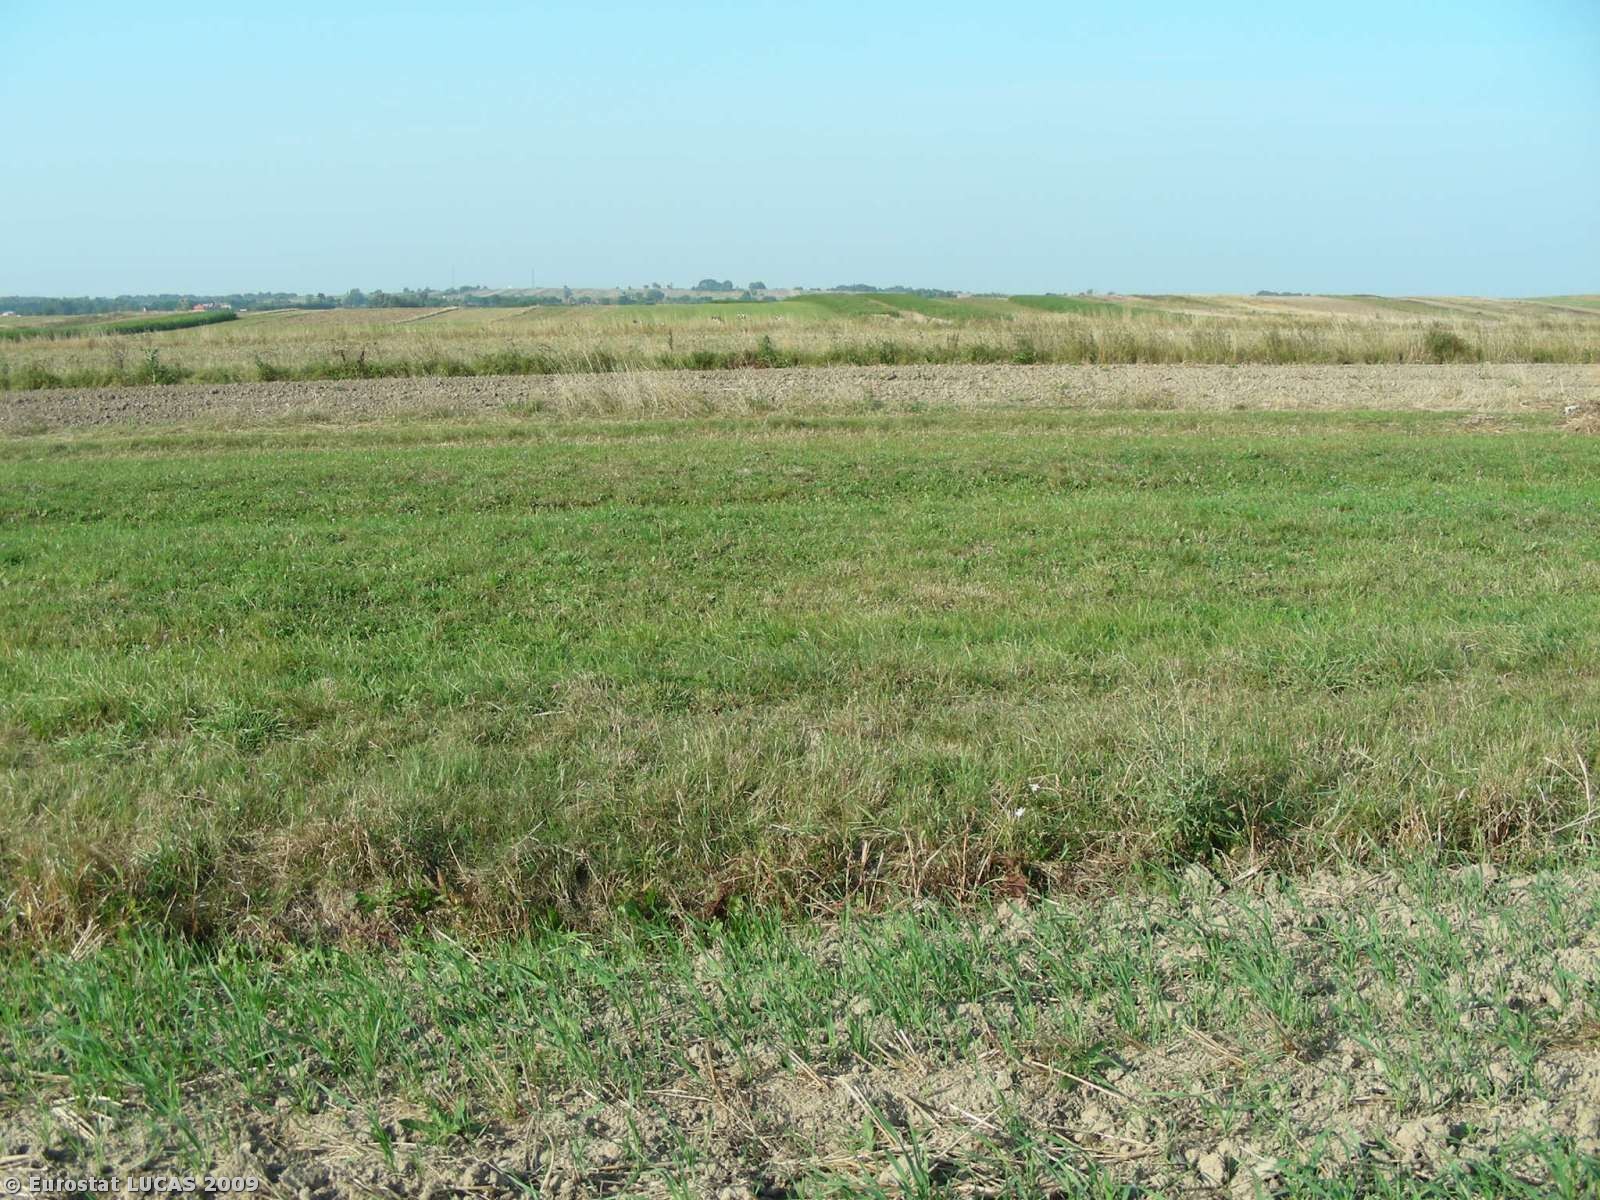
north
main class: Cropland
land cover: Potatoes
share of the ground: < 10 %
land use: Agriculture (excluding fallow land and kitchen gardens)
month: September
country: PL
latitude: 50.3519
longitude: 22.1325
